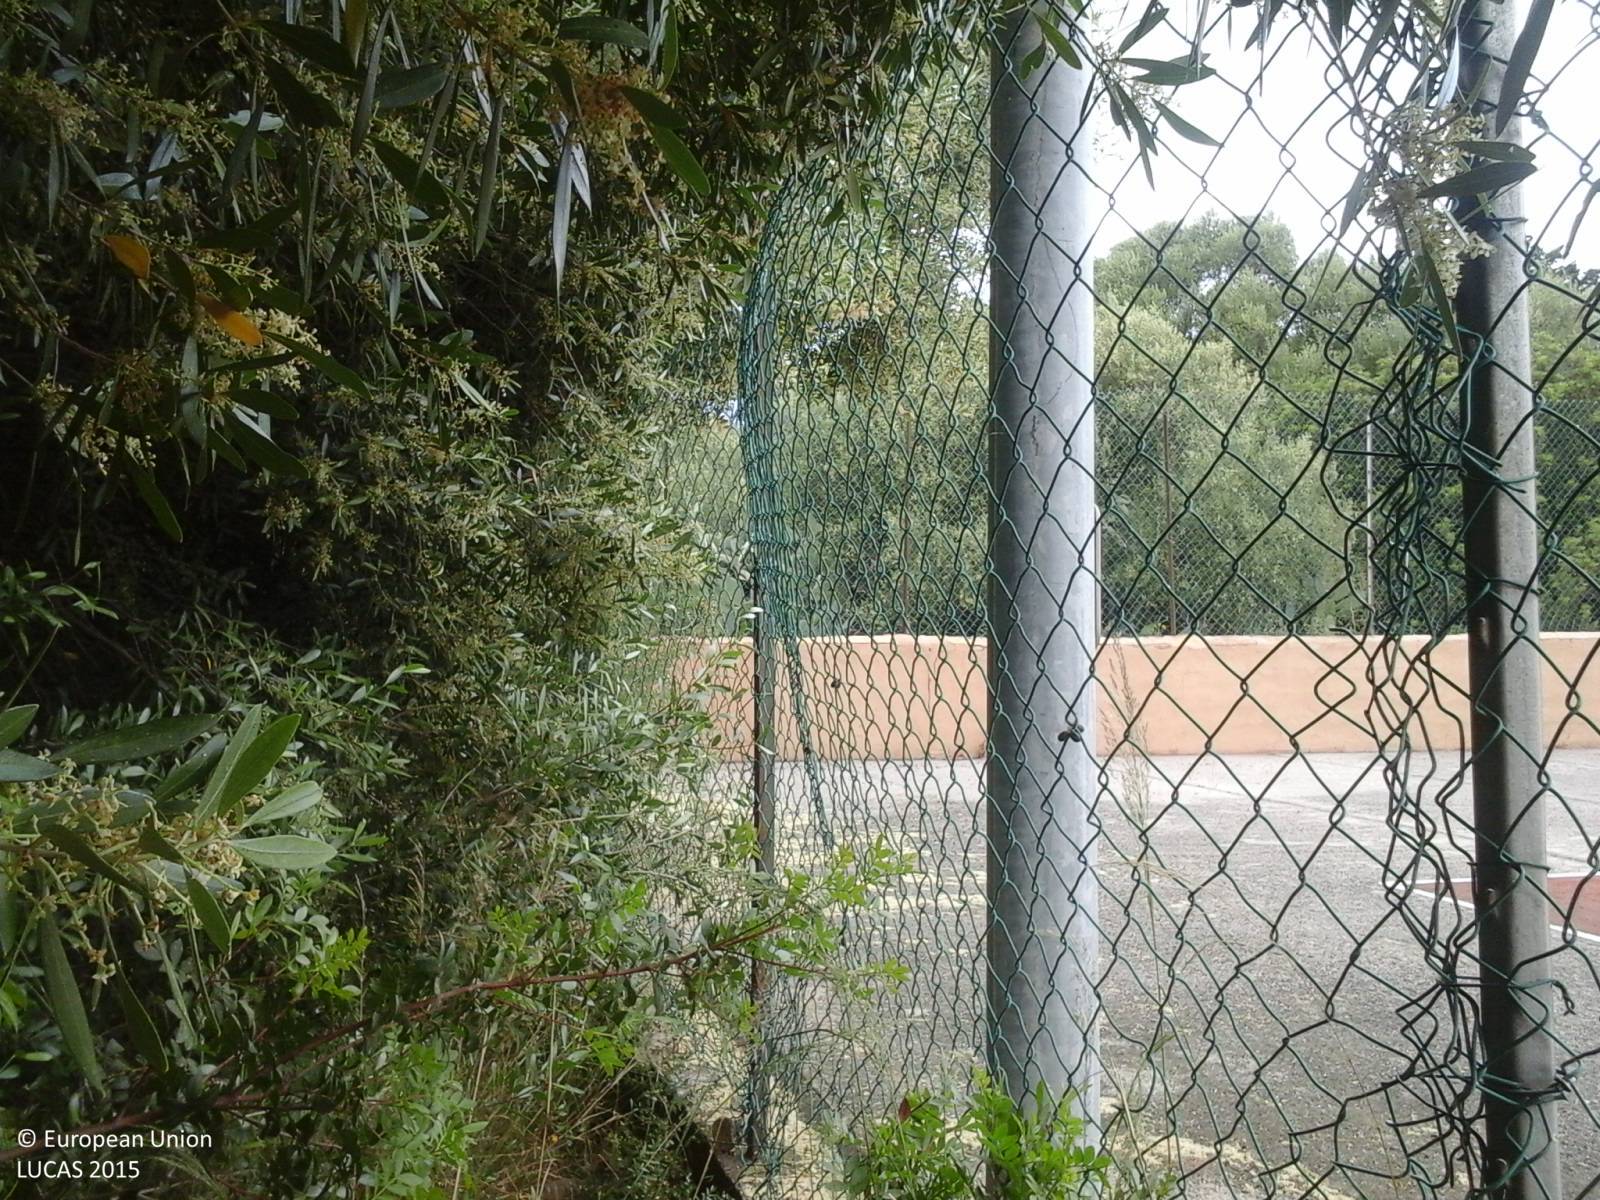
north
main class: Woodland
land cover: Broadleaved woodland
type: broadleaved evergreen forest
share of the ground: > 75 %
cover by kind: broadleaved forest trees 45 %, shrubs 45 %
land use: Amenities, museums, leisure
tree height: > 5 m
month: May
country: IT
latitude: 40.9667
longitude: 8.8764
